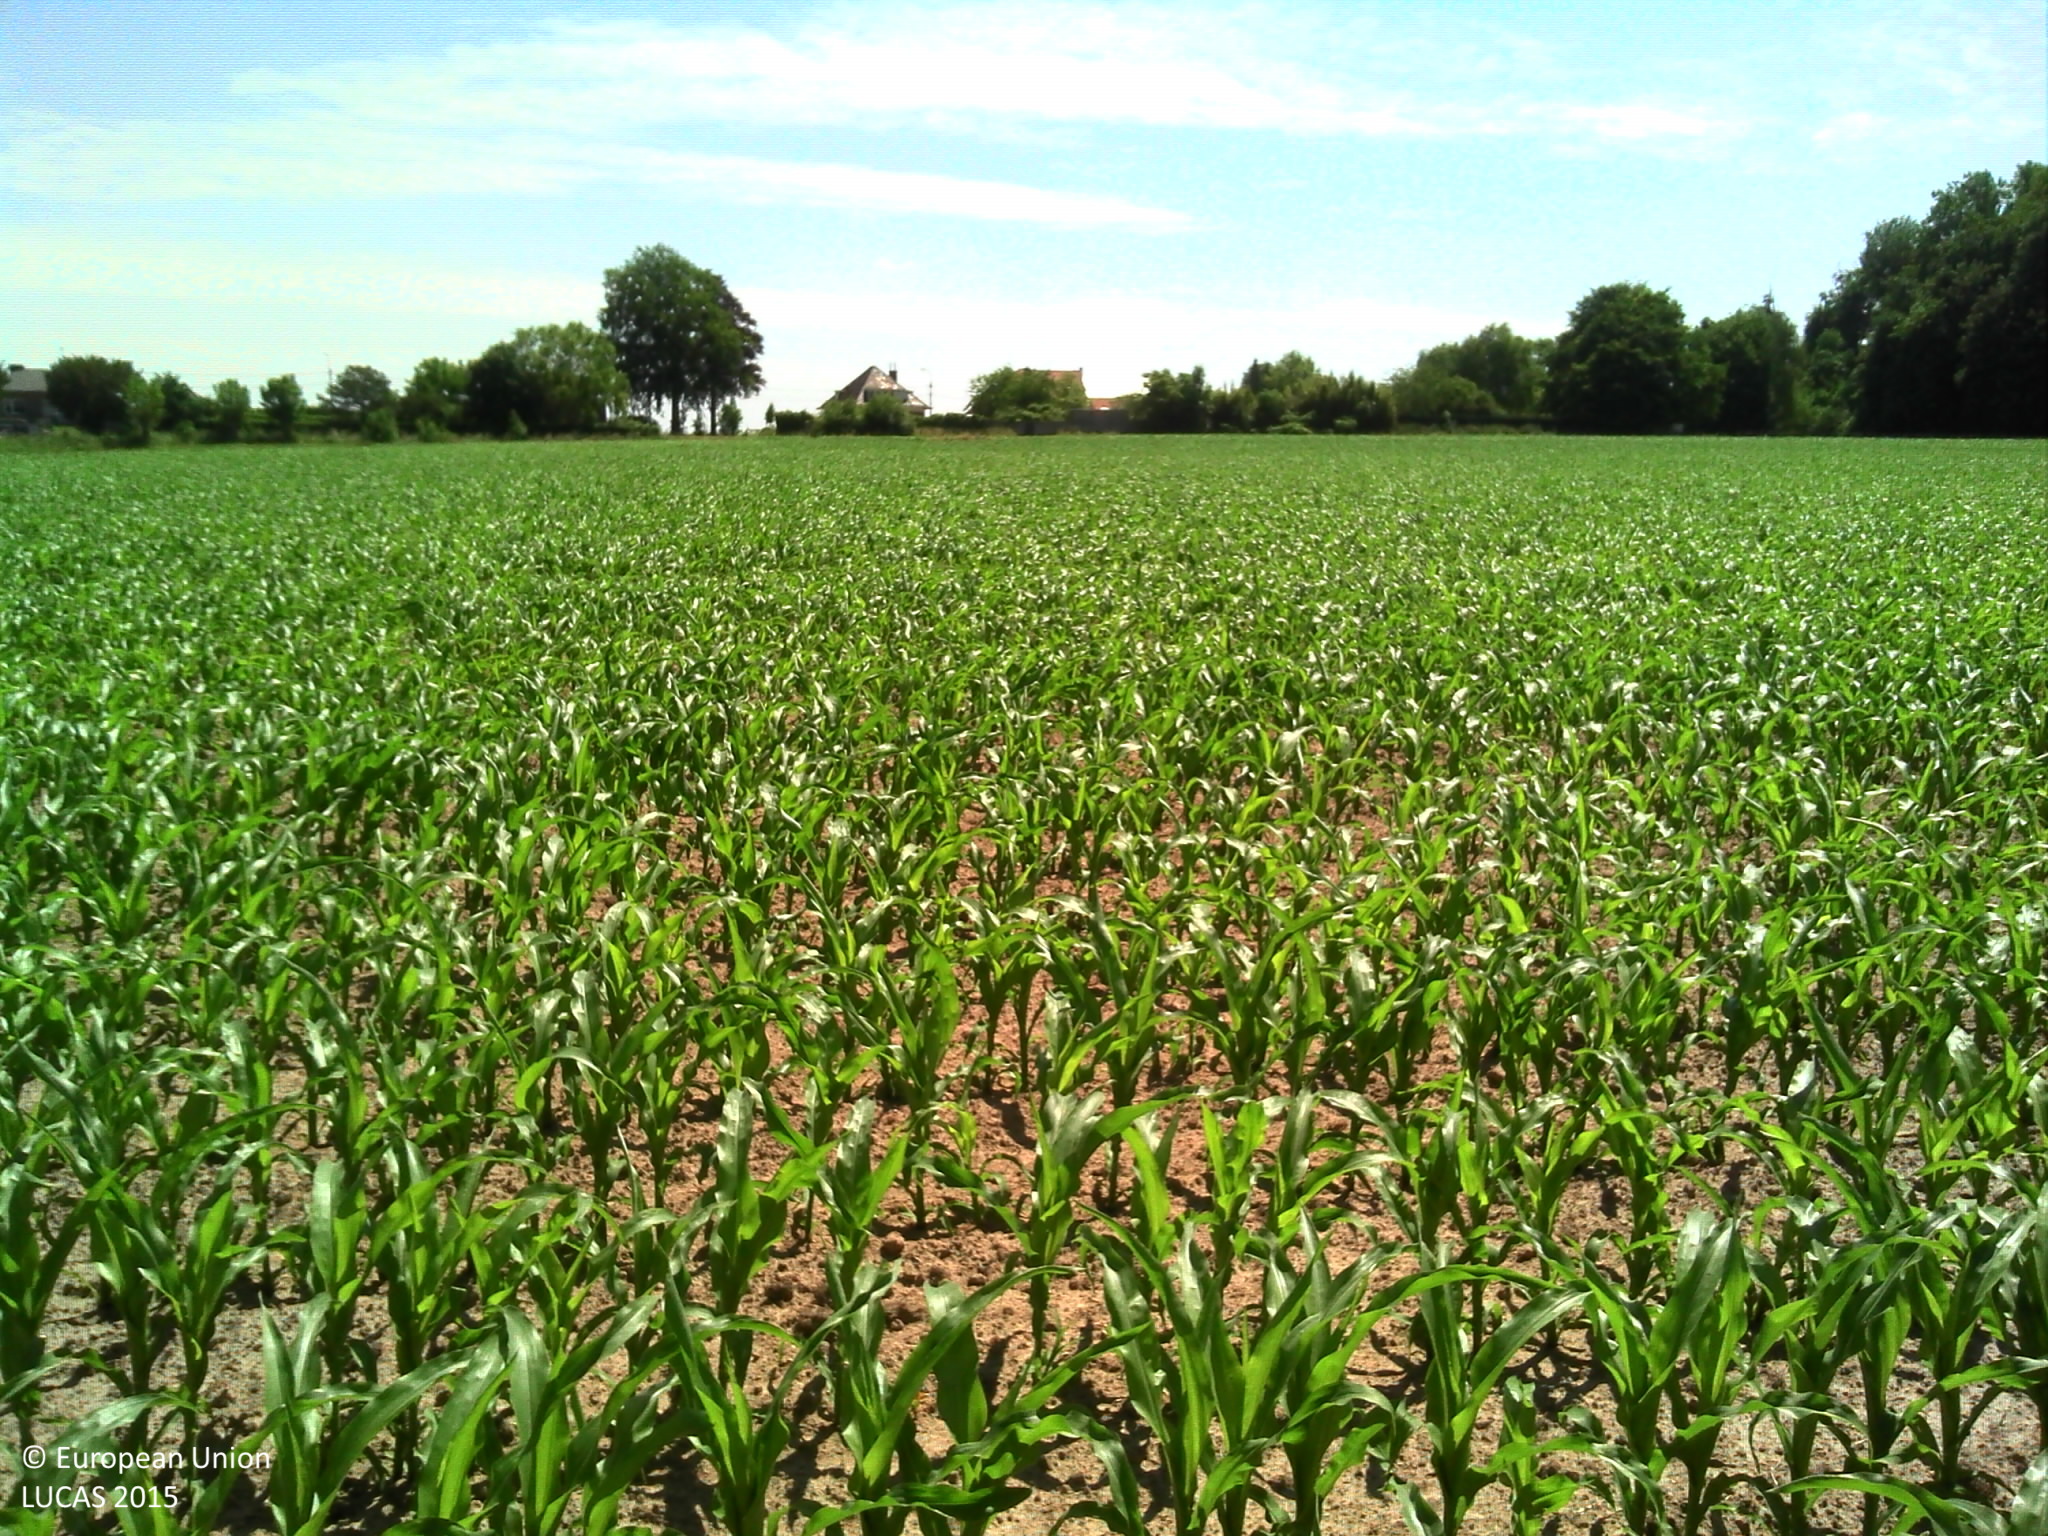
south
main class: Cropland
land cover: Maize
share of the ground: > 75 %
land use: Agriculture (excluding fallow land and kitchen gardens)
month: June
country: BE
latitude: 50.7425
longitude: 3.5730
